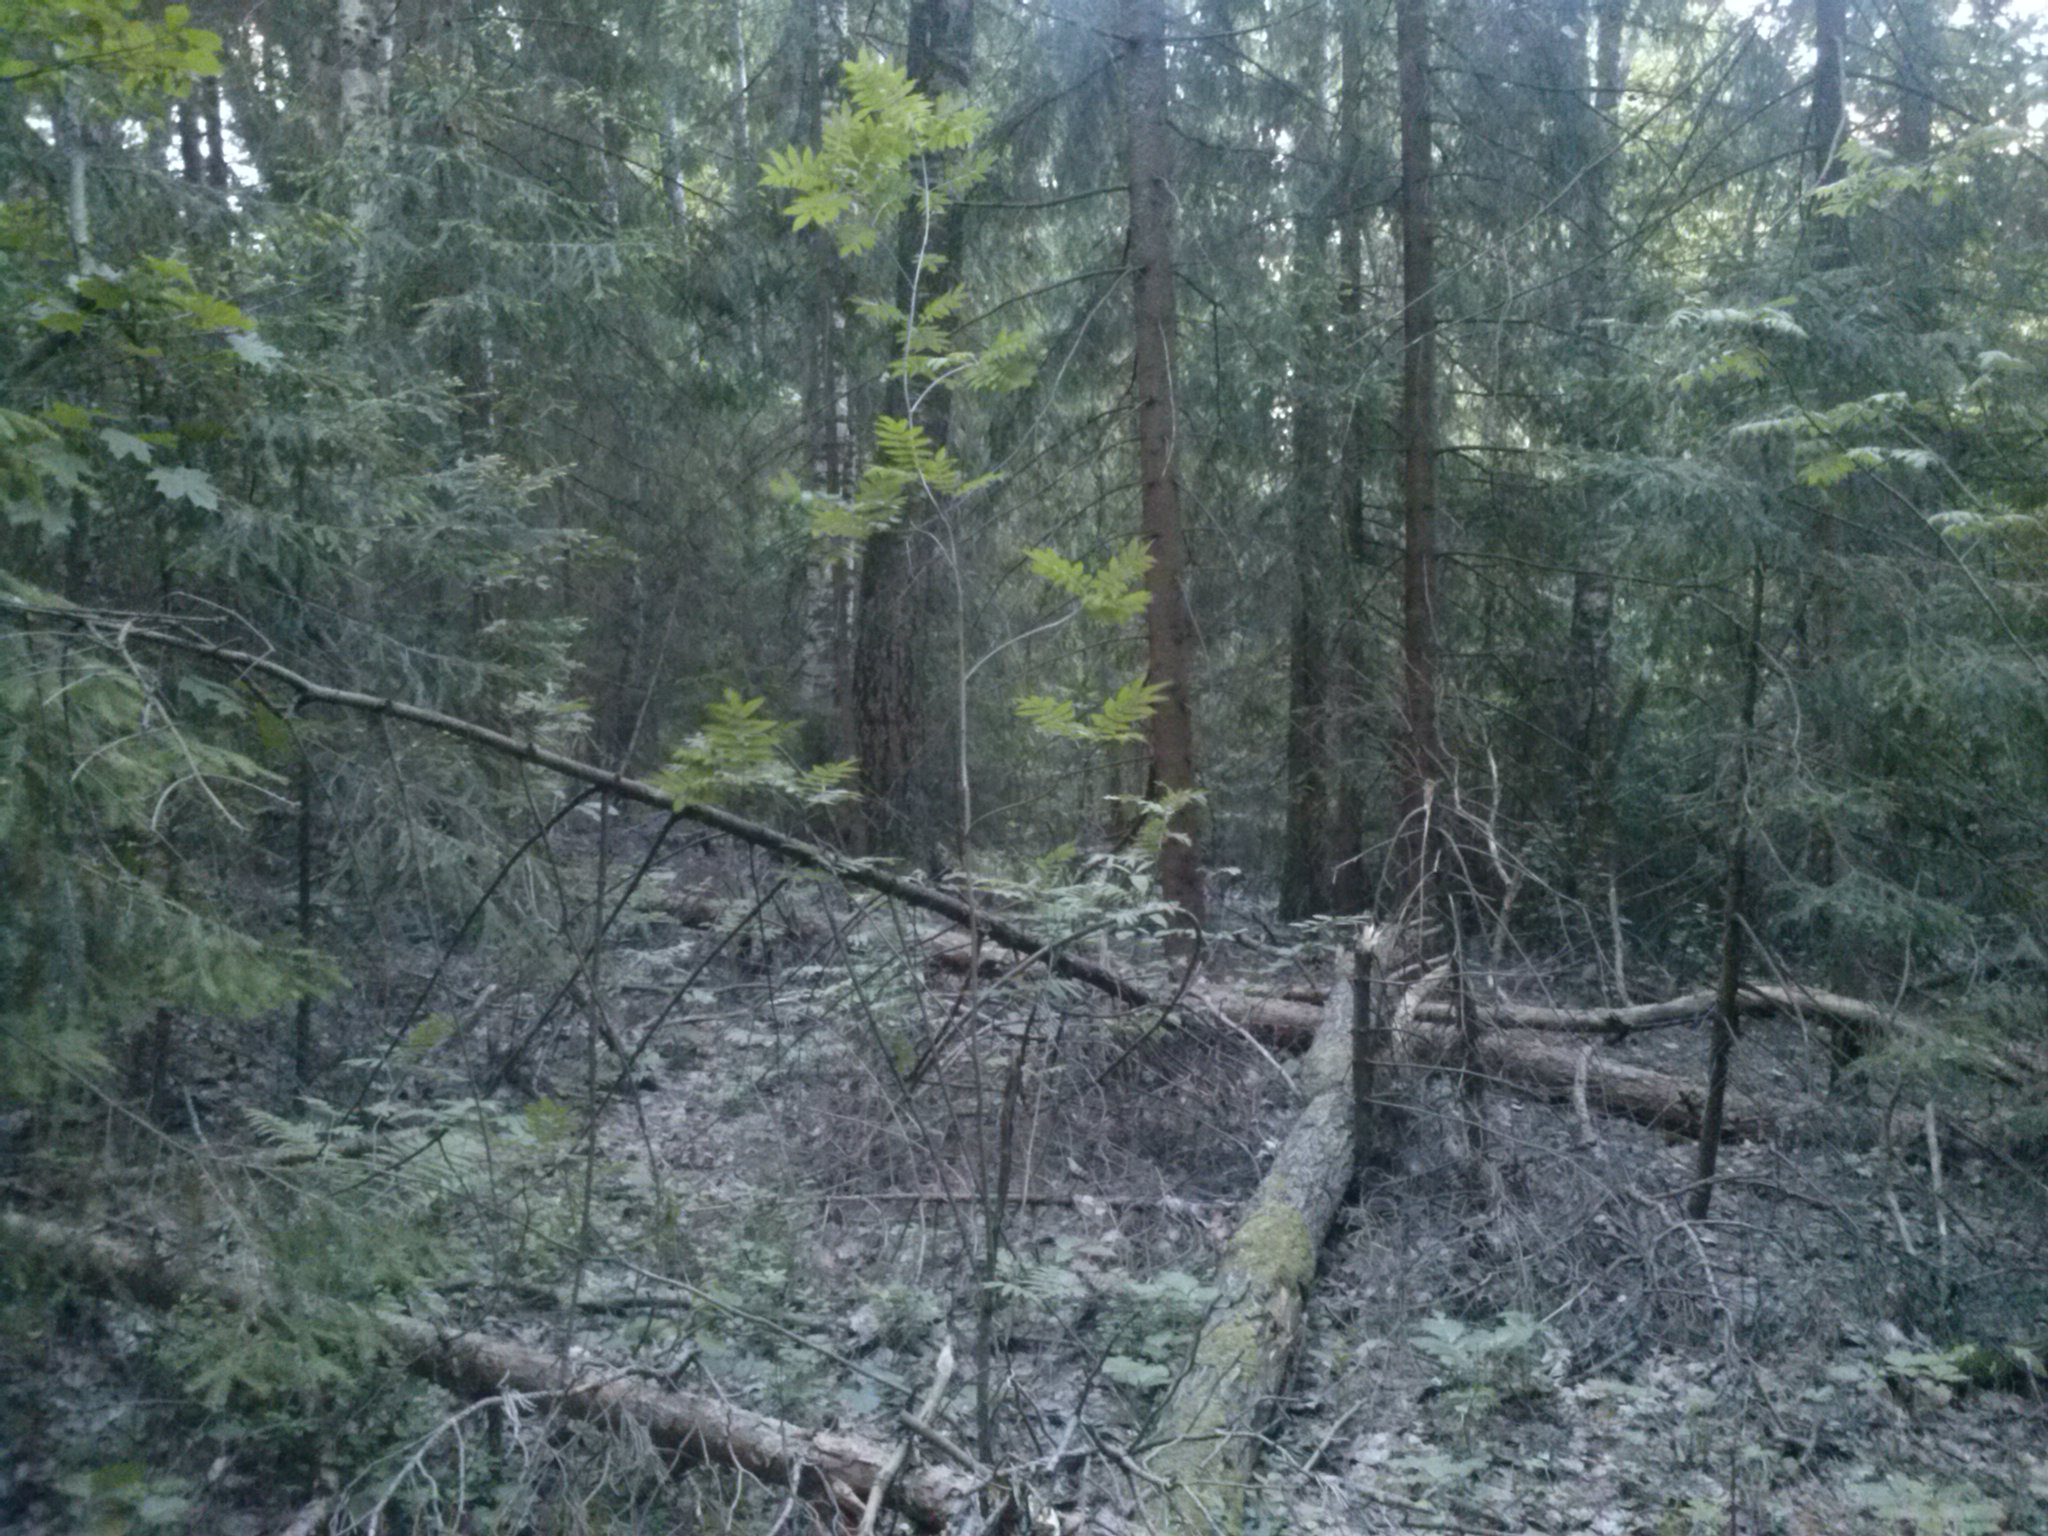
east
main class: Woodland
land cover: Other coniferous woodland
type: hemiboreal forest and nemoral coniferous forest and mixed broadleaved-coniferous forest
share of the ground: > 75 %
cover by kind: coniferous forest trees 75 %, broadleaved forest trees 25 %
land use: Forestry
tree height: > 5 m
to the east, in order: Other coniferous woodland; Other mixed woodland; Grassland without tree/shrub cover; Other coniferous woodland
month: June
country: LV
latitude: 56.3830
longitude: 27.8278
